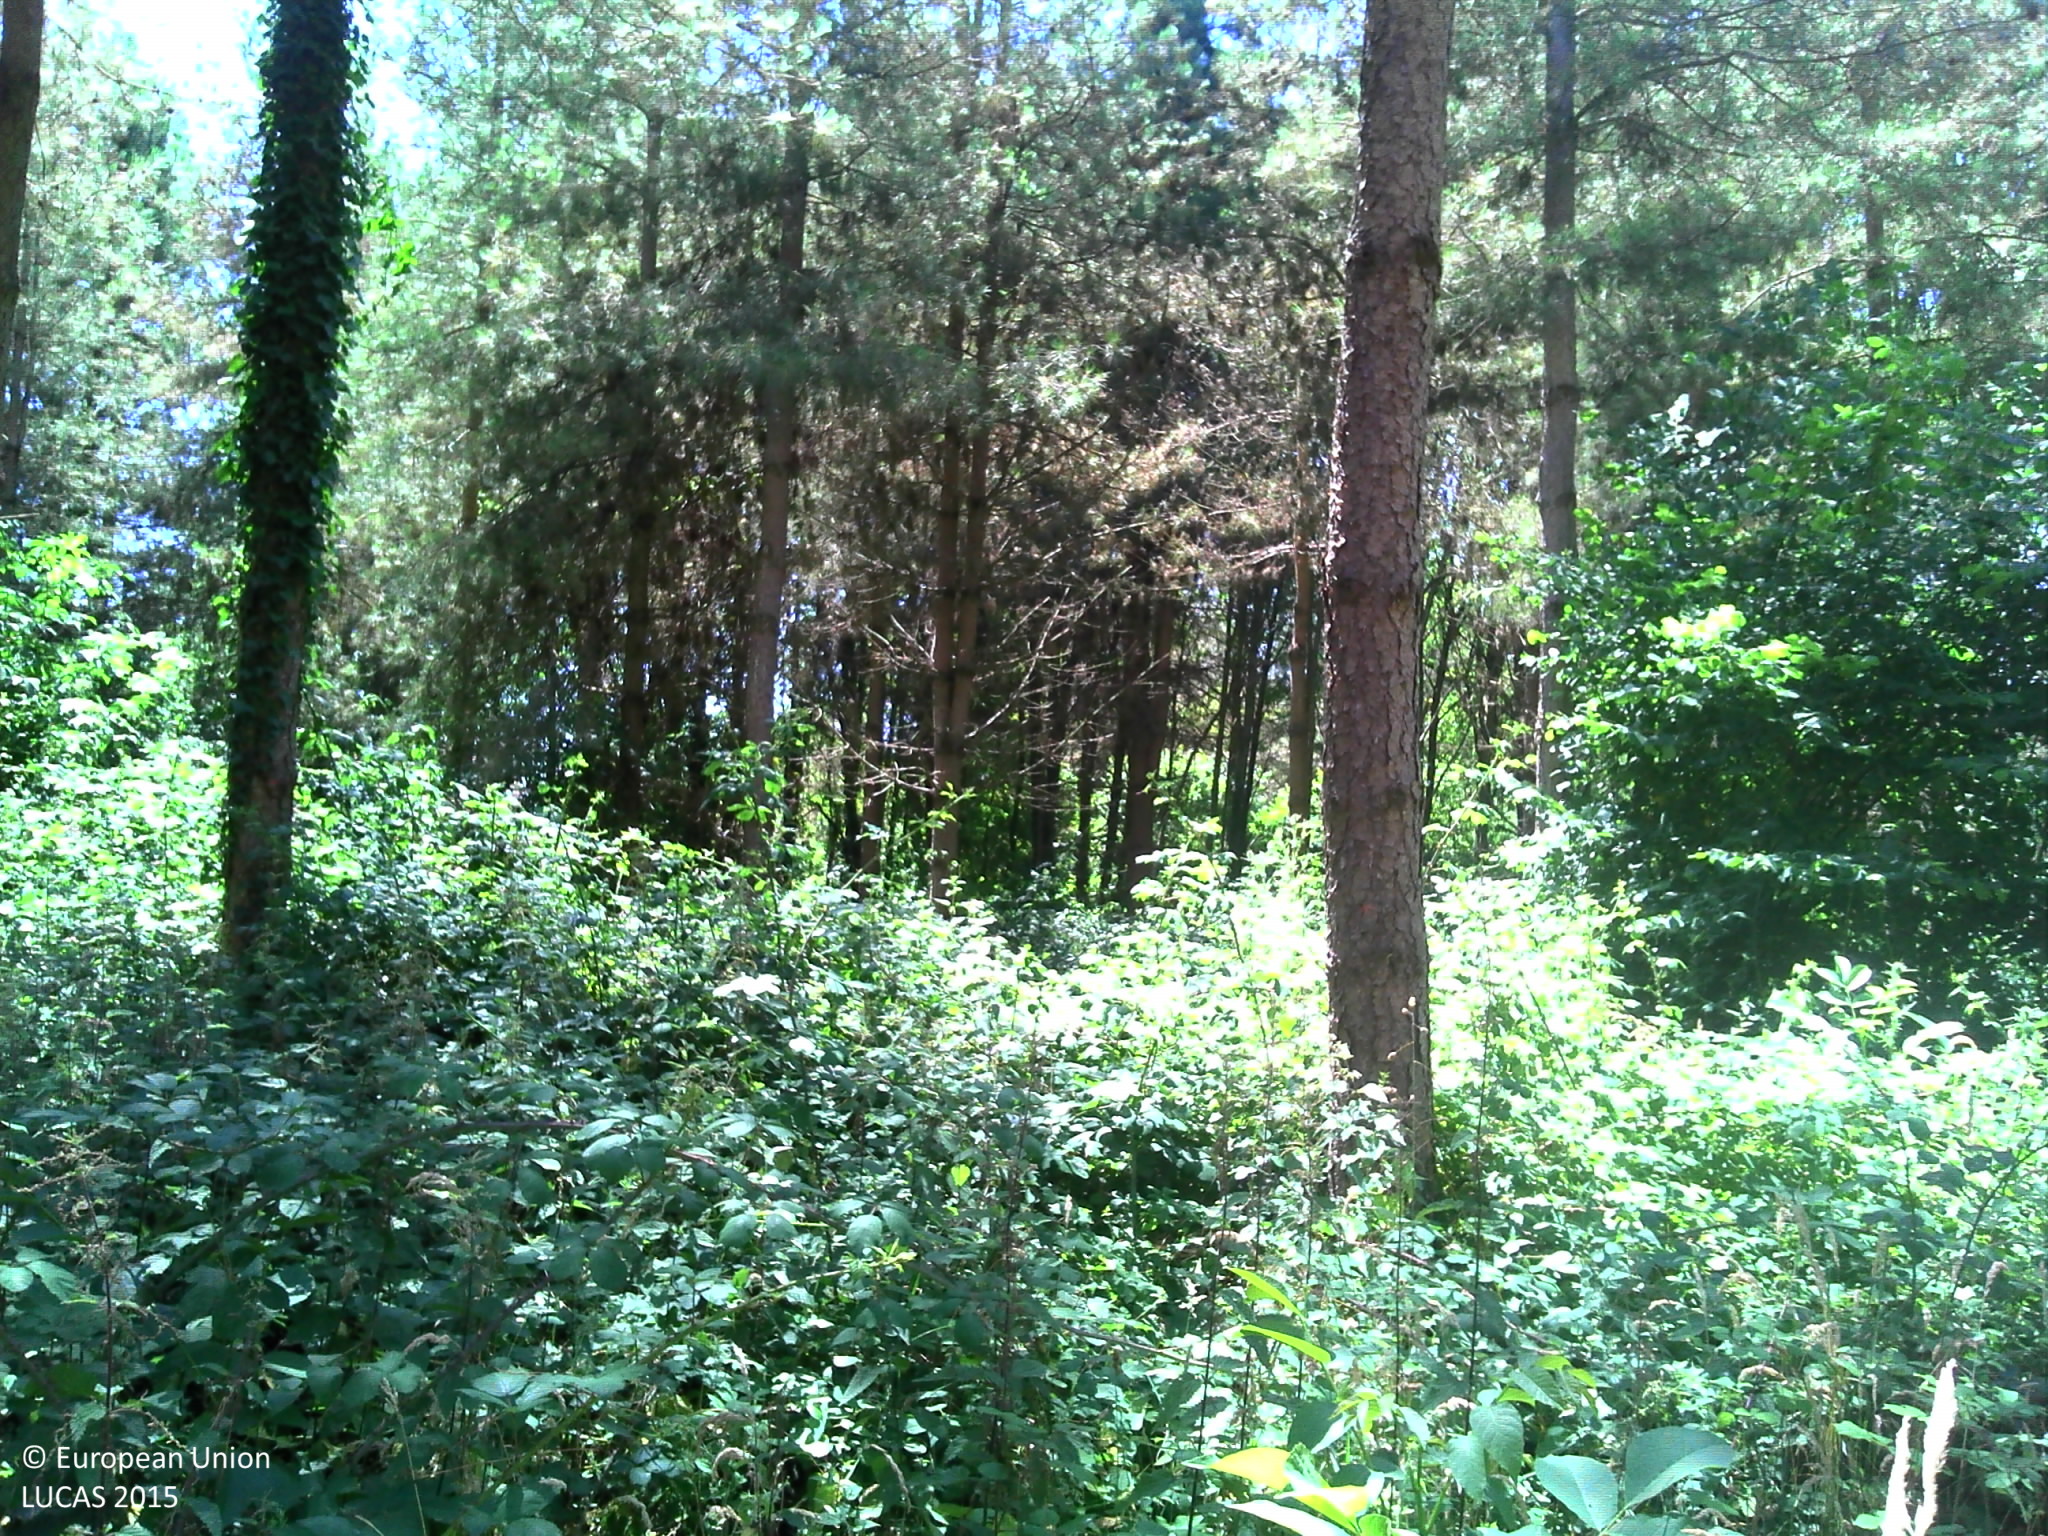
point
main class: Woodland
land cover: Spruce dominated coniferous woodland
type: exotic forest
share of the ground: > 75 %
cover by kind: coniferous forest trees 75 %, shrubs 15 %, herbaceous plants 10 %
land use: Forestry
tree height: > 5 m
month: June
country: FR
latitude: 47.9953
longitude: 0.3126
